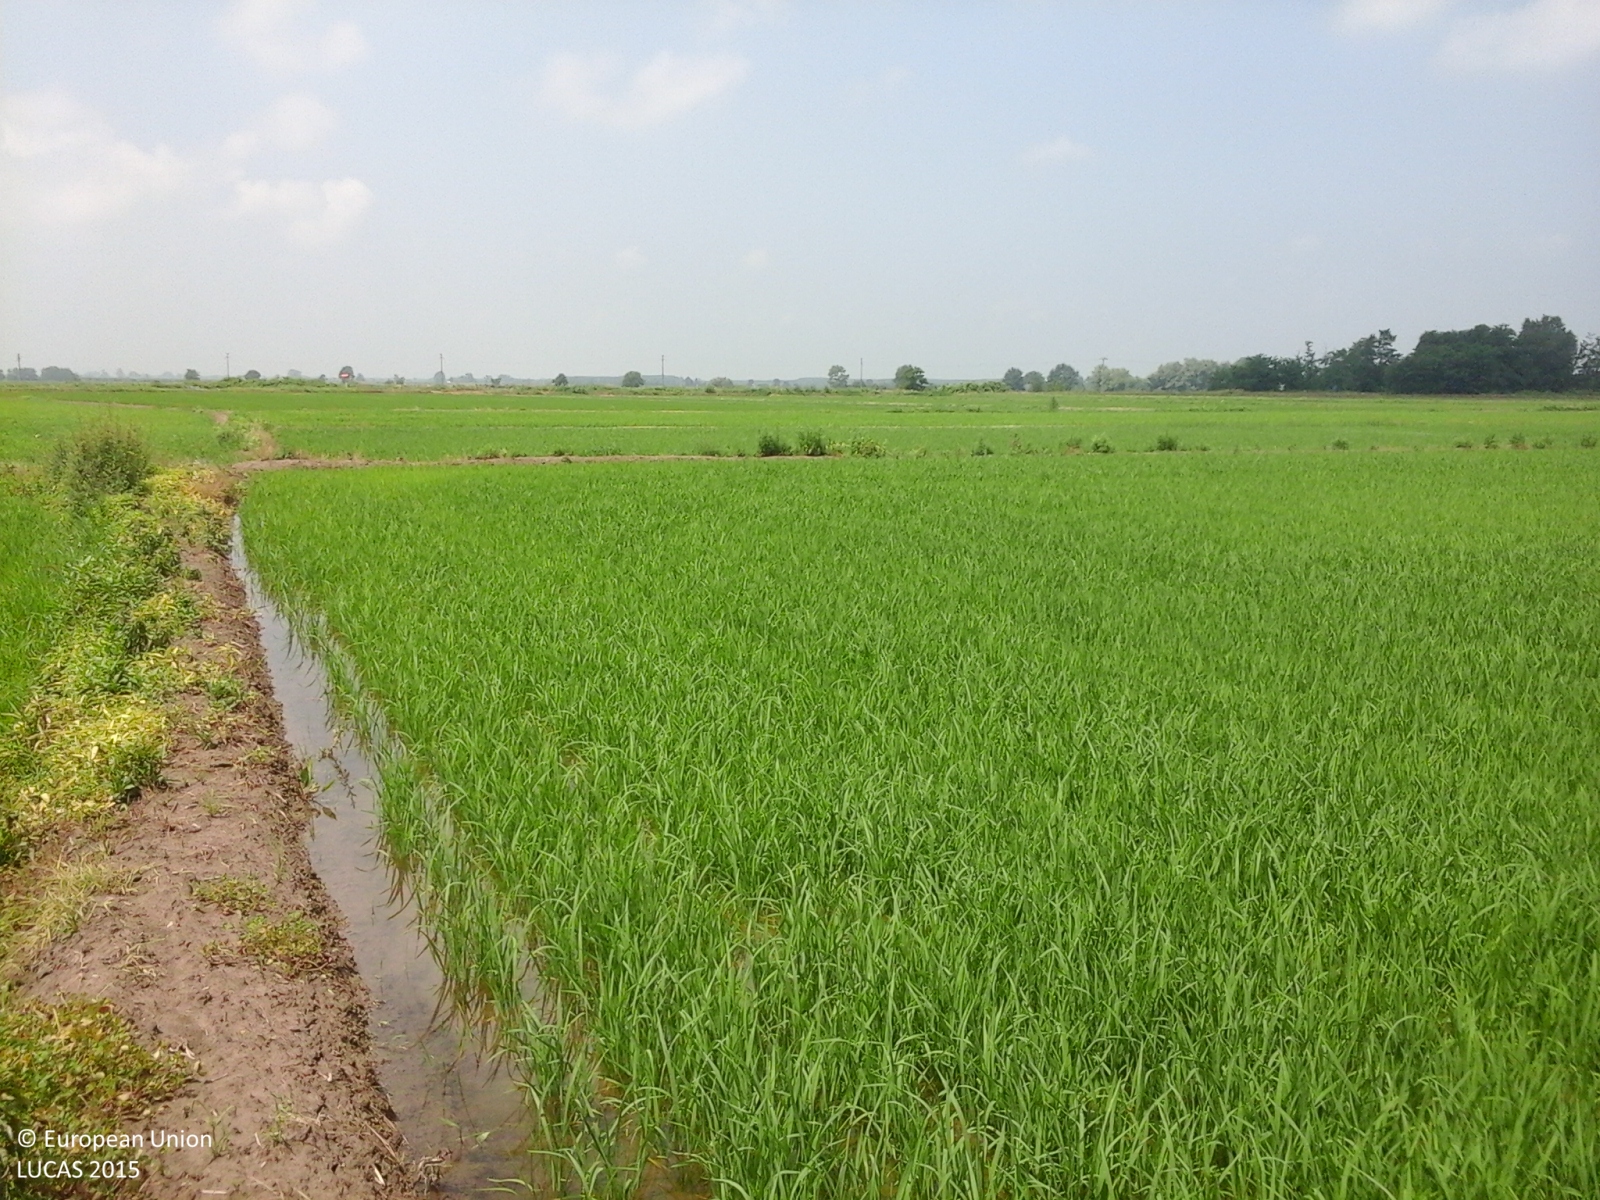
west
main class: Cropland
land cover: Rice
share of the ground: > 75 %
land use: Agriculture (excluding fallow land and kitchen gardens)
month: June
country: IT
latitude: 45.2426
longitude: 8.5884
